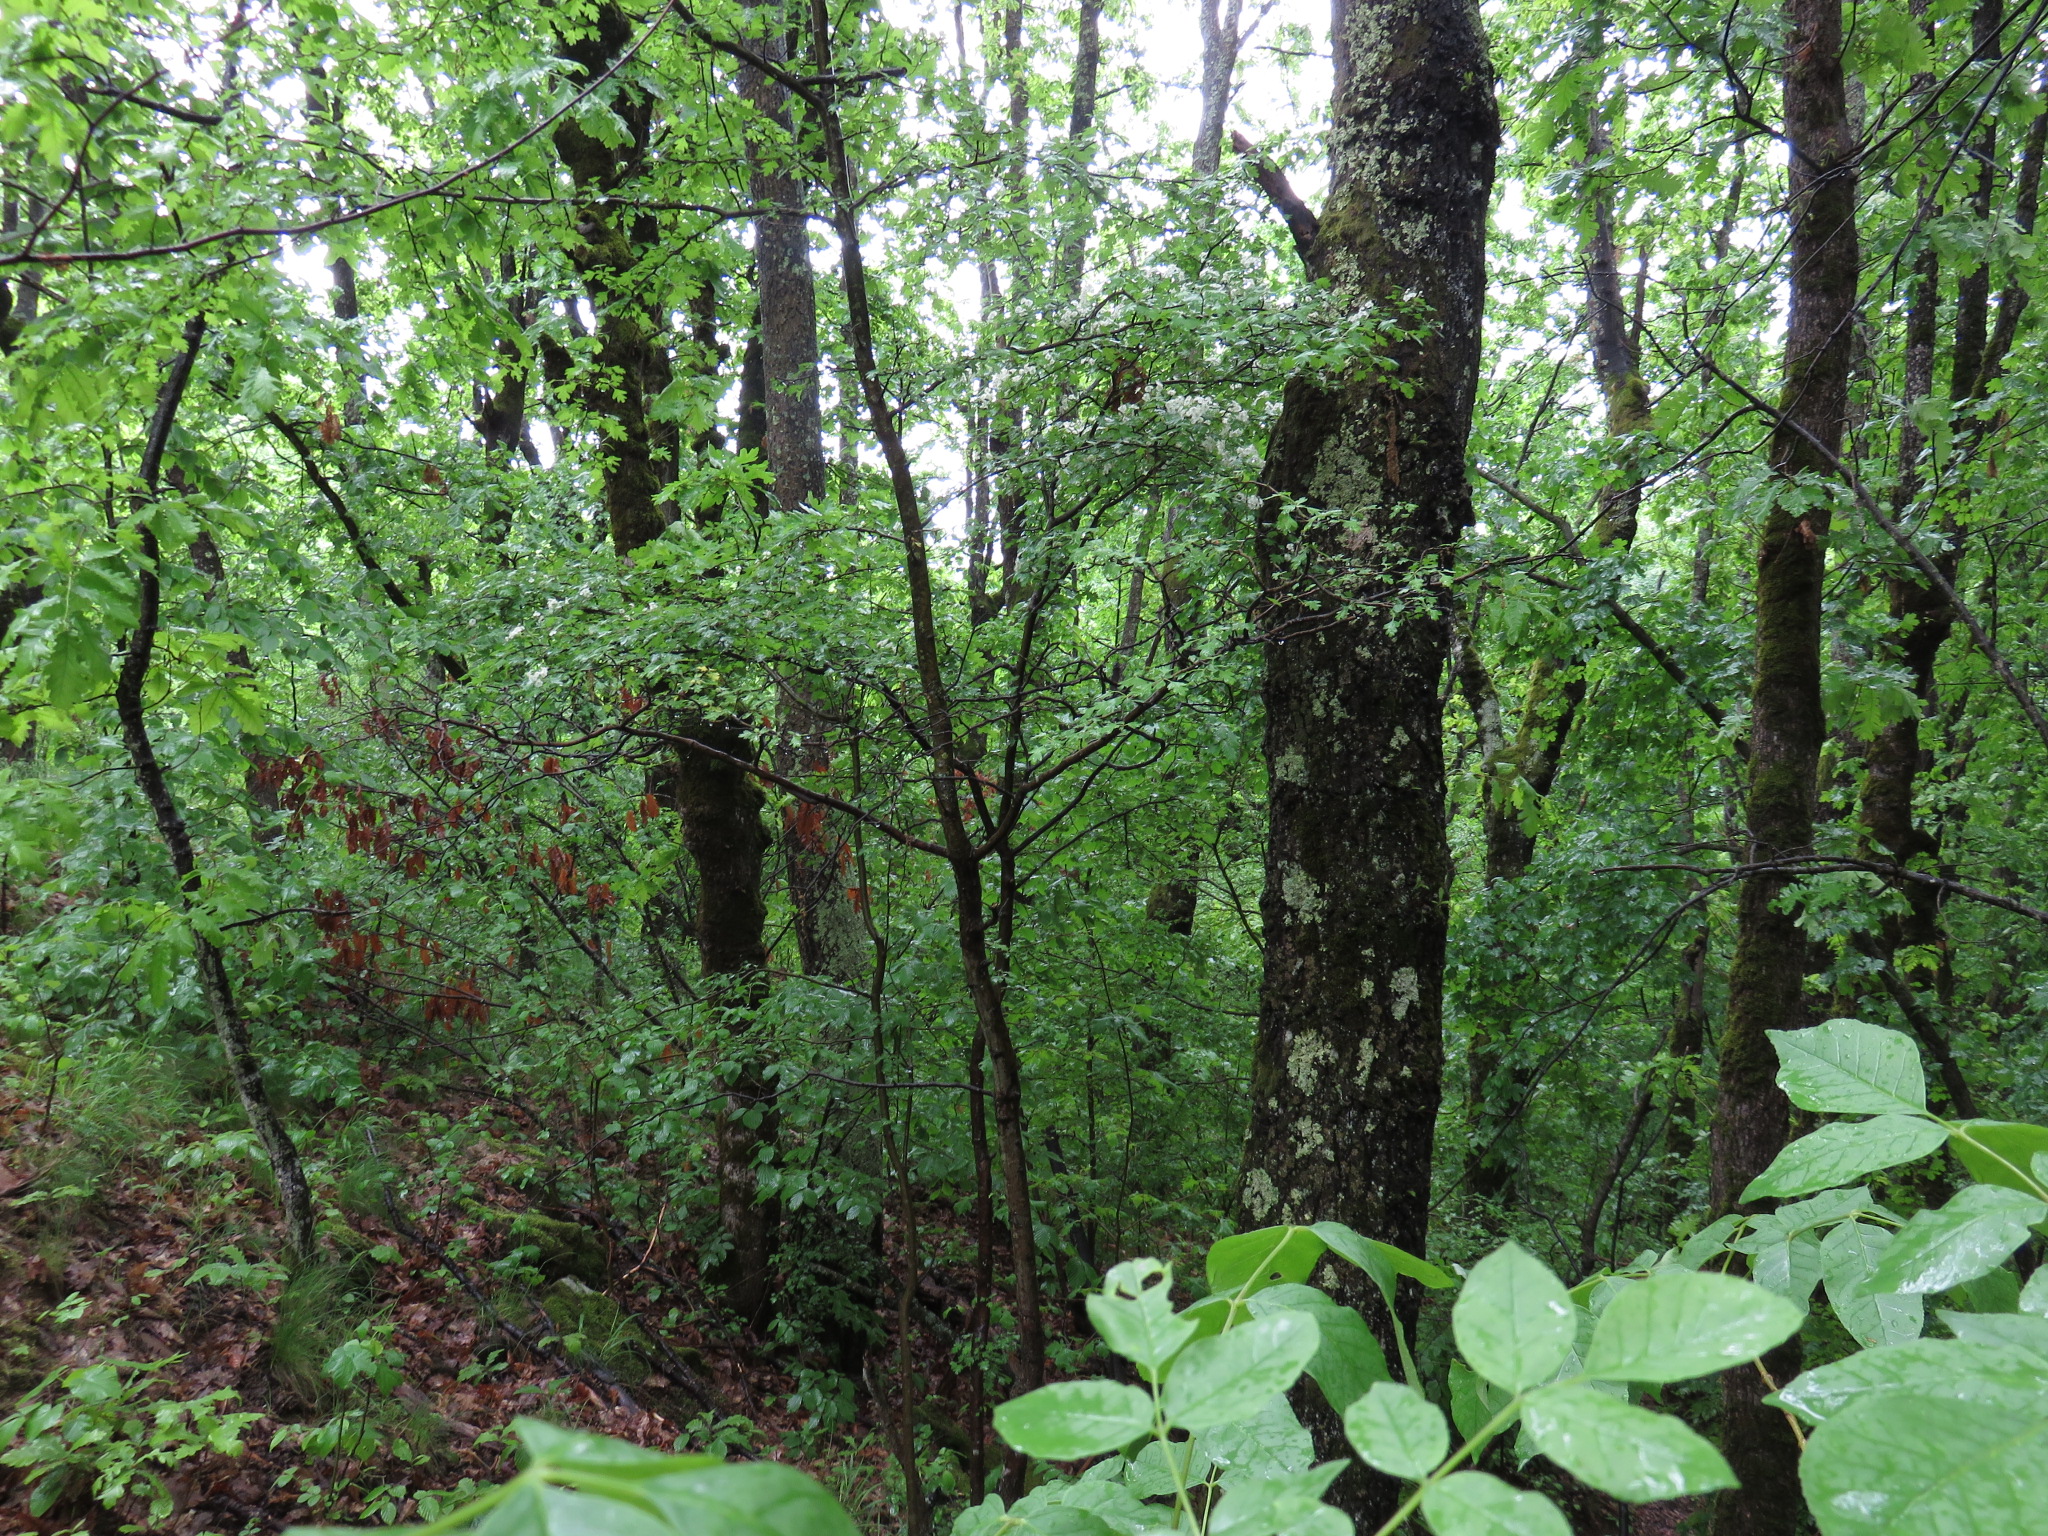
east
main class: Woodland
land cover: Broadleaved woodland
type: mesophytic deciduous forest
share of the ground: > 75 %
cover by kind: broadleaved forest trees 95 %, shrubs 5 %
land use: Forestry
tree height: < 5 m
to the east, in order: Broadleaved woodland; Rivers and streams; Broadleaved woodland
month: May
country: BG
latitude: 42.9340
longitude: 24.8024
